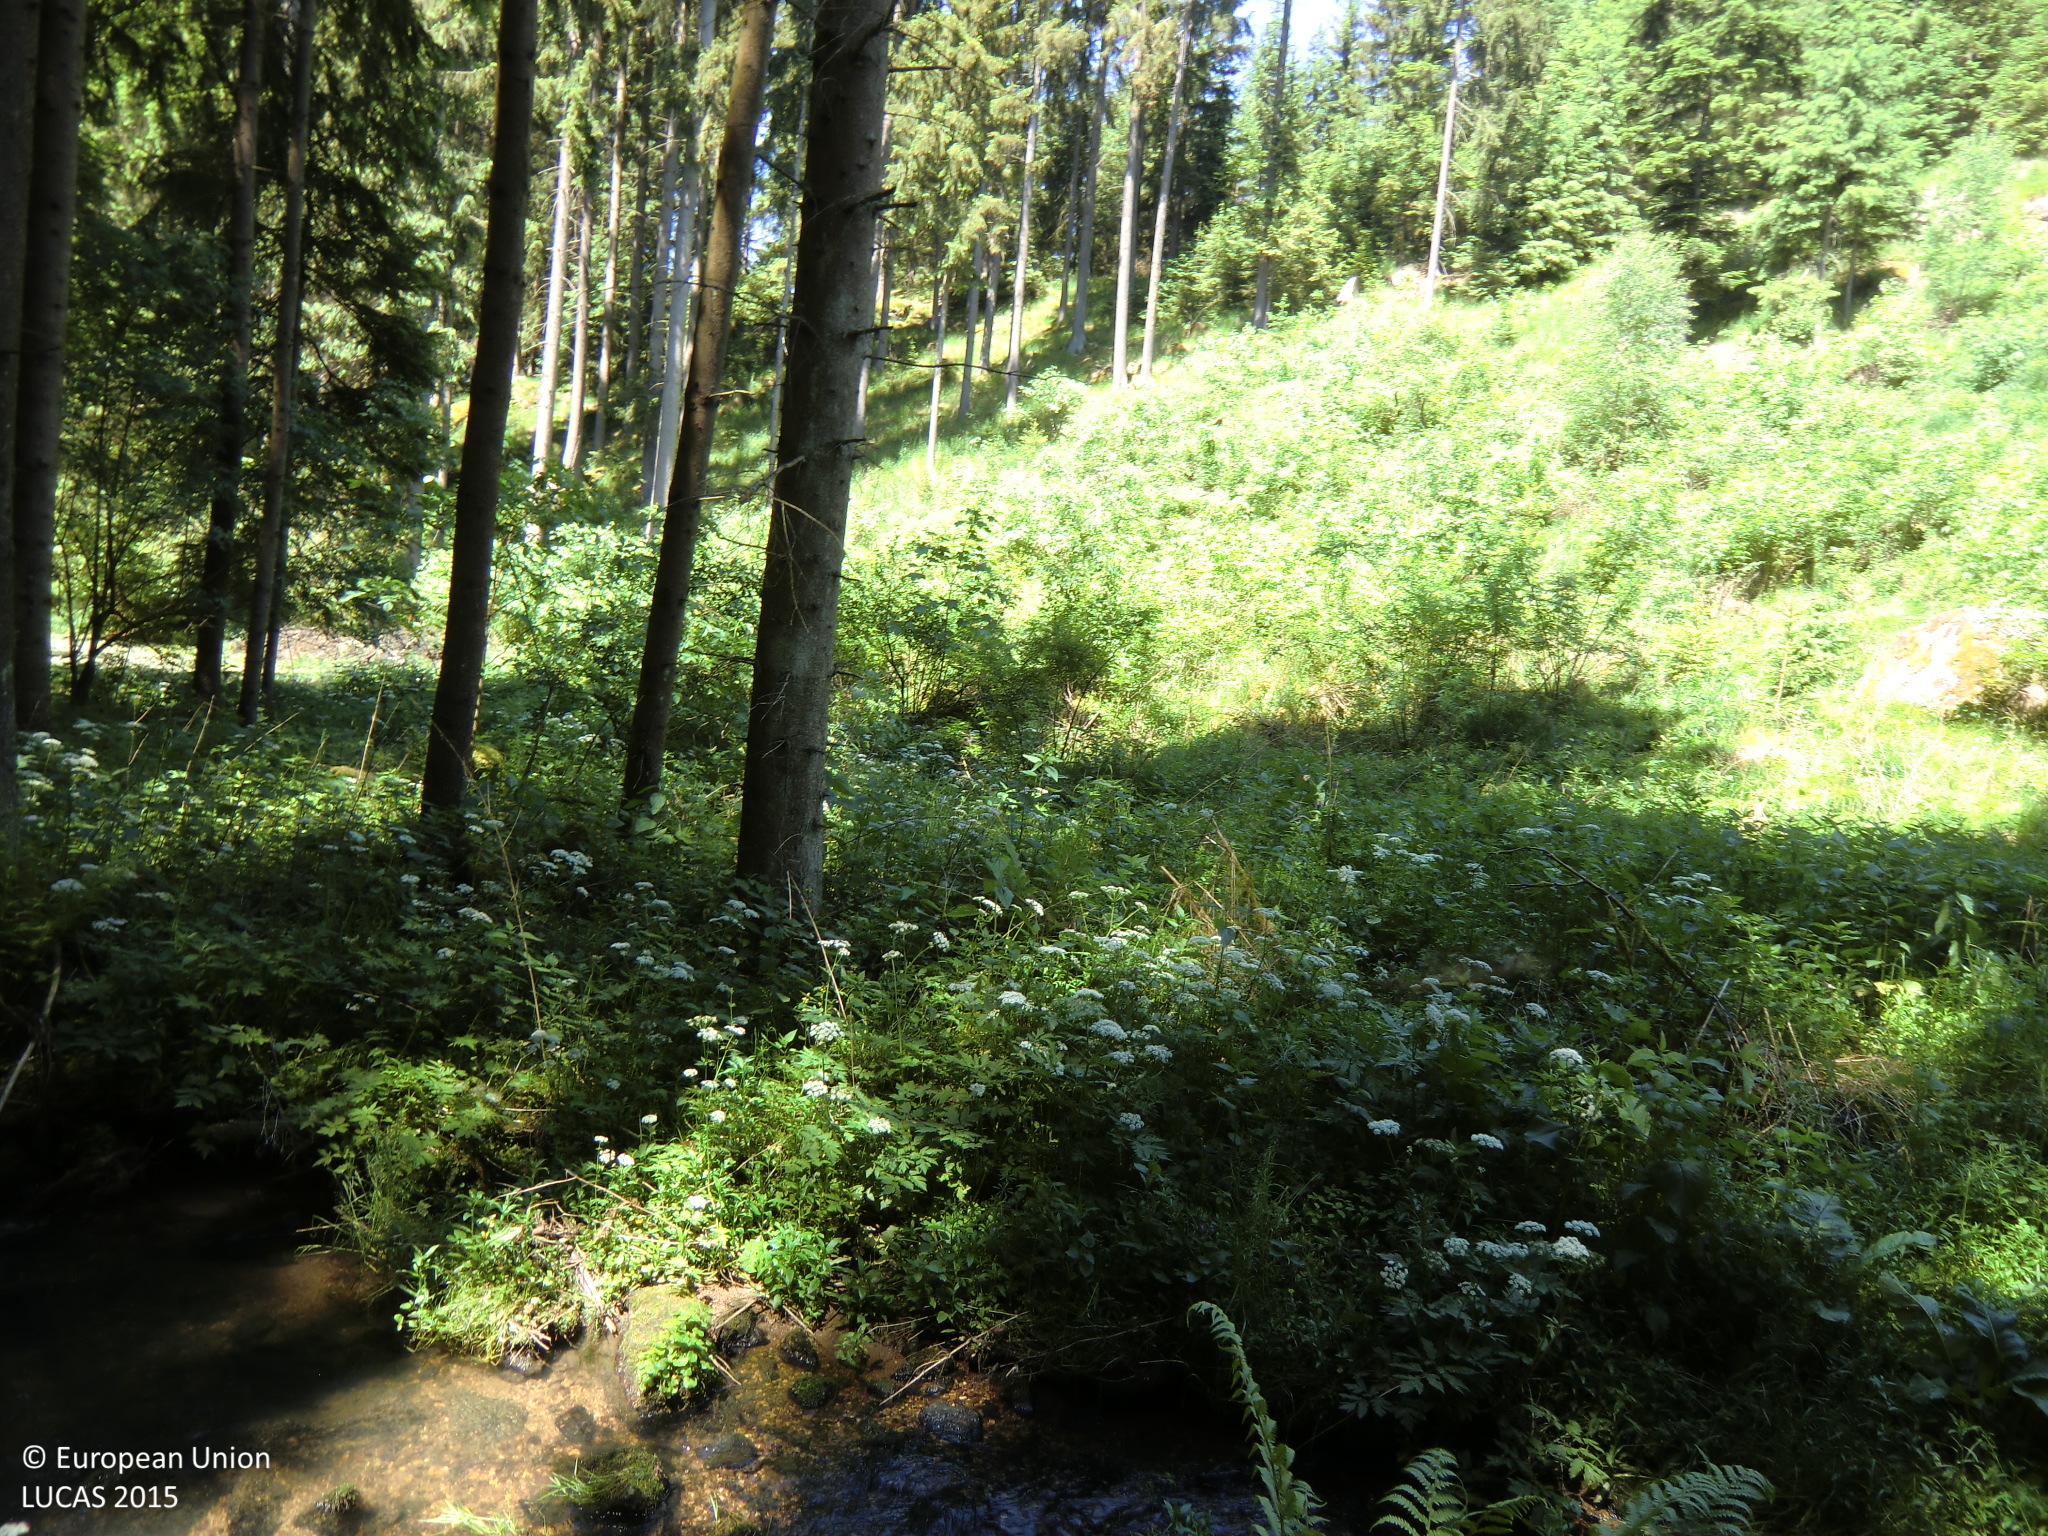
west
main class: Woodland
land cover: Spruce dominated coniferous woodland
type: hemiboreal forest and nemoral coniferous forest and mixed broadleaved-coniferous forest
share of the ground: > 75 %
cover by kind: coniferous forest trees 80 %, herbaceous plants 20 %
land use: Forestry
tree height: > 5 m
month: June
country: AT
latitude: 48.5680
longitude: 14.4050
